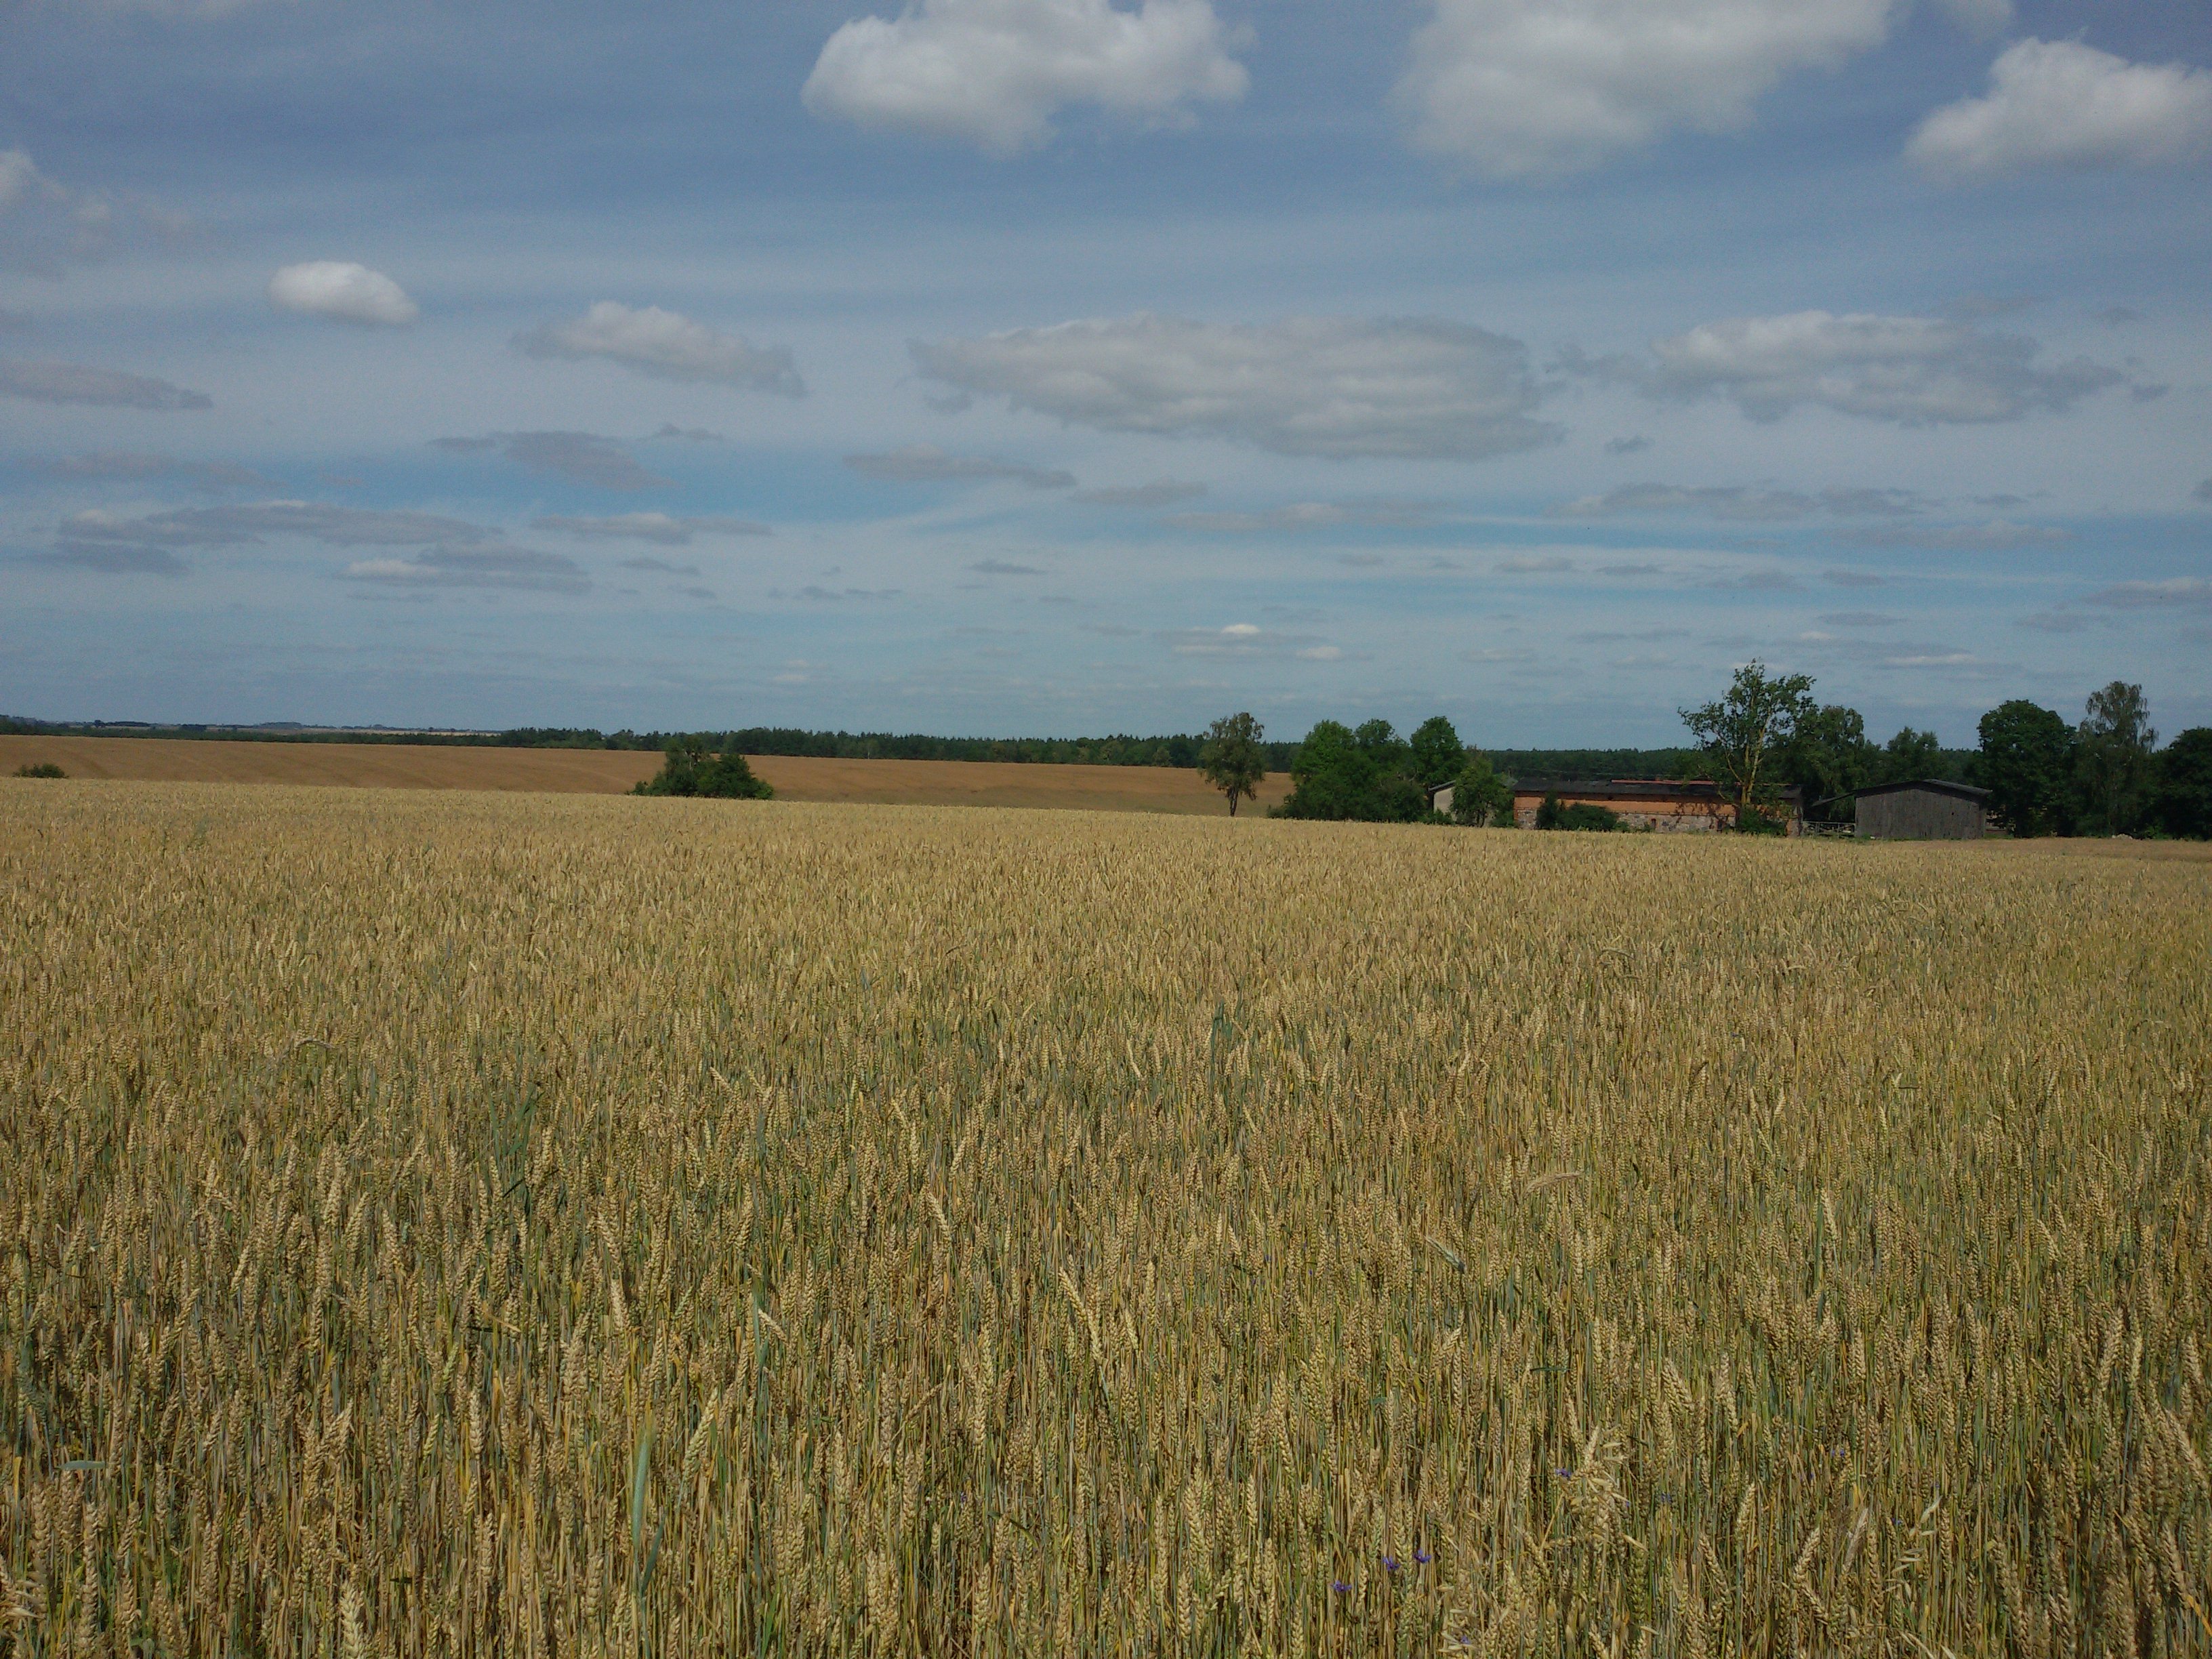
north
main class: Cropland
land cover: Common wheat
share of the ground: > 75 %
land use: Agriculture (excluding fallow land and kitchen gardens)
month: August
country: PL
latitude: 53.5533
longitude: 17.1191
